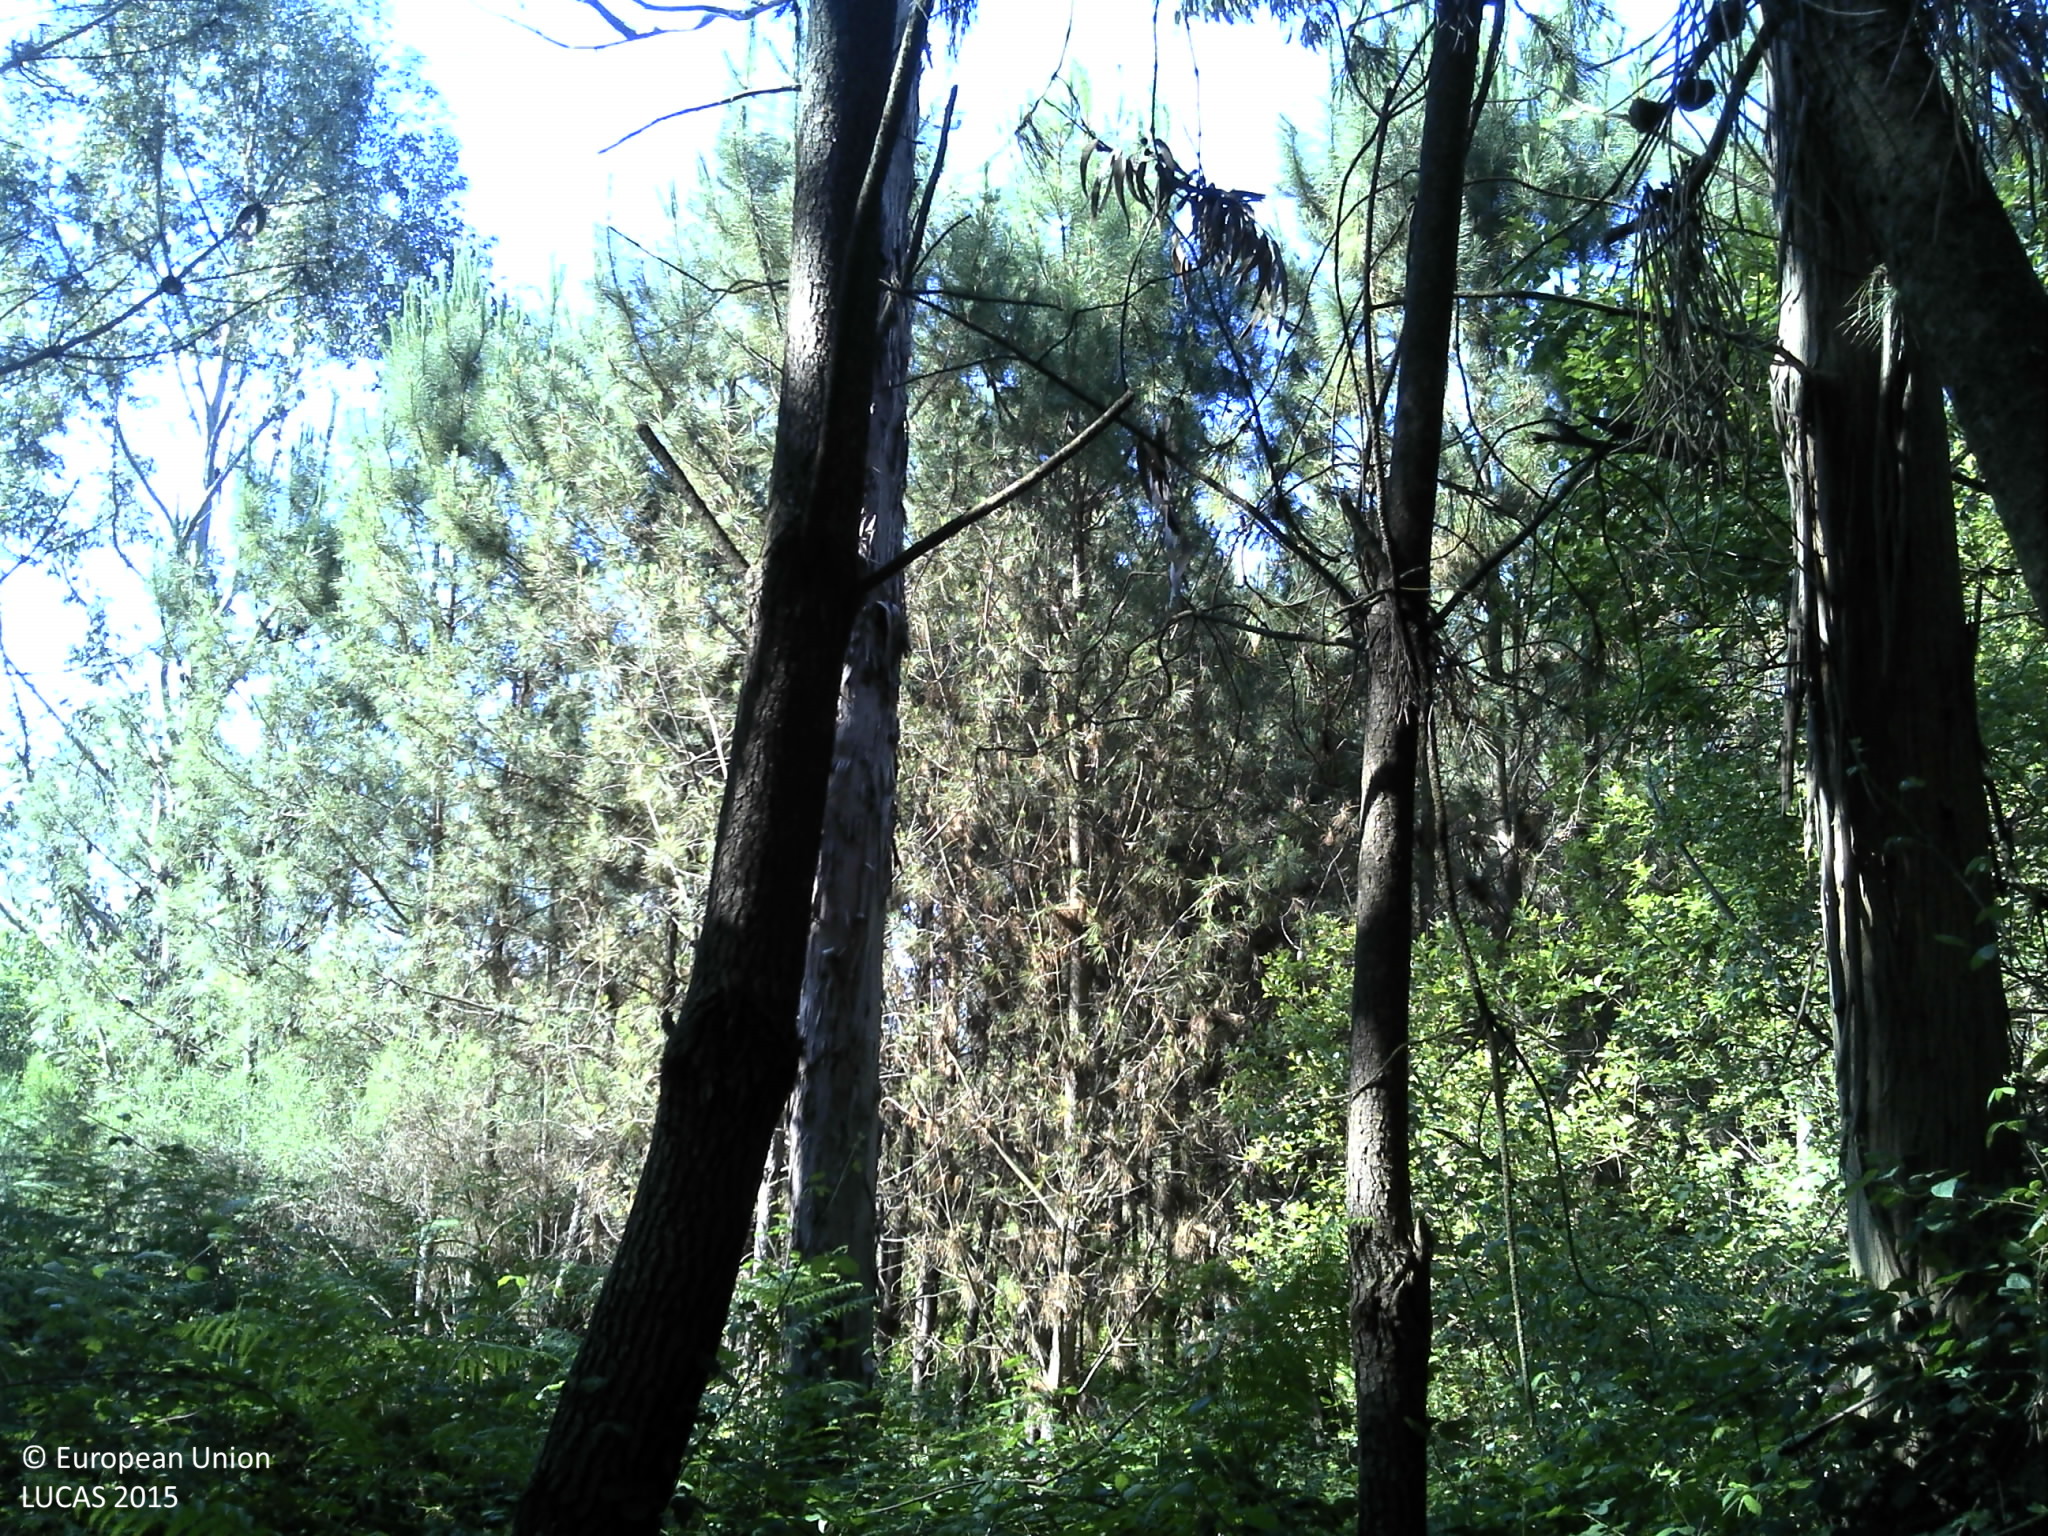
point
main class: Woodland
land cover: Pine dominated coniferous woodland
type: coniferous forest of the mediterranean region
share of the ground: 50 - 75 %
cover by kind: coniferous forest trees 75 %, broadleaved forest trees 20 %, shrubs 5 %
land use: Forestry
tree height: > 5 m
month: May
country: PT
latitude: 41.9724
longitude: -8.6677
